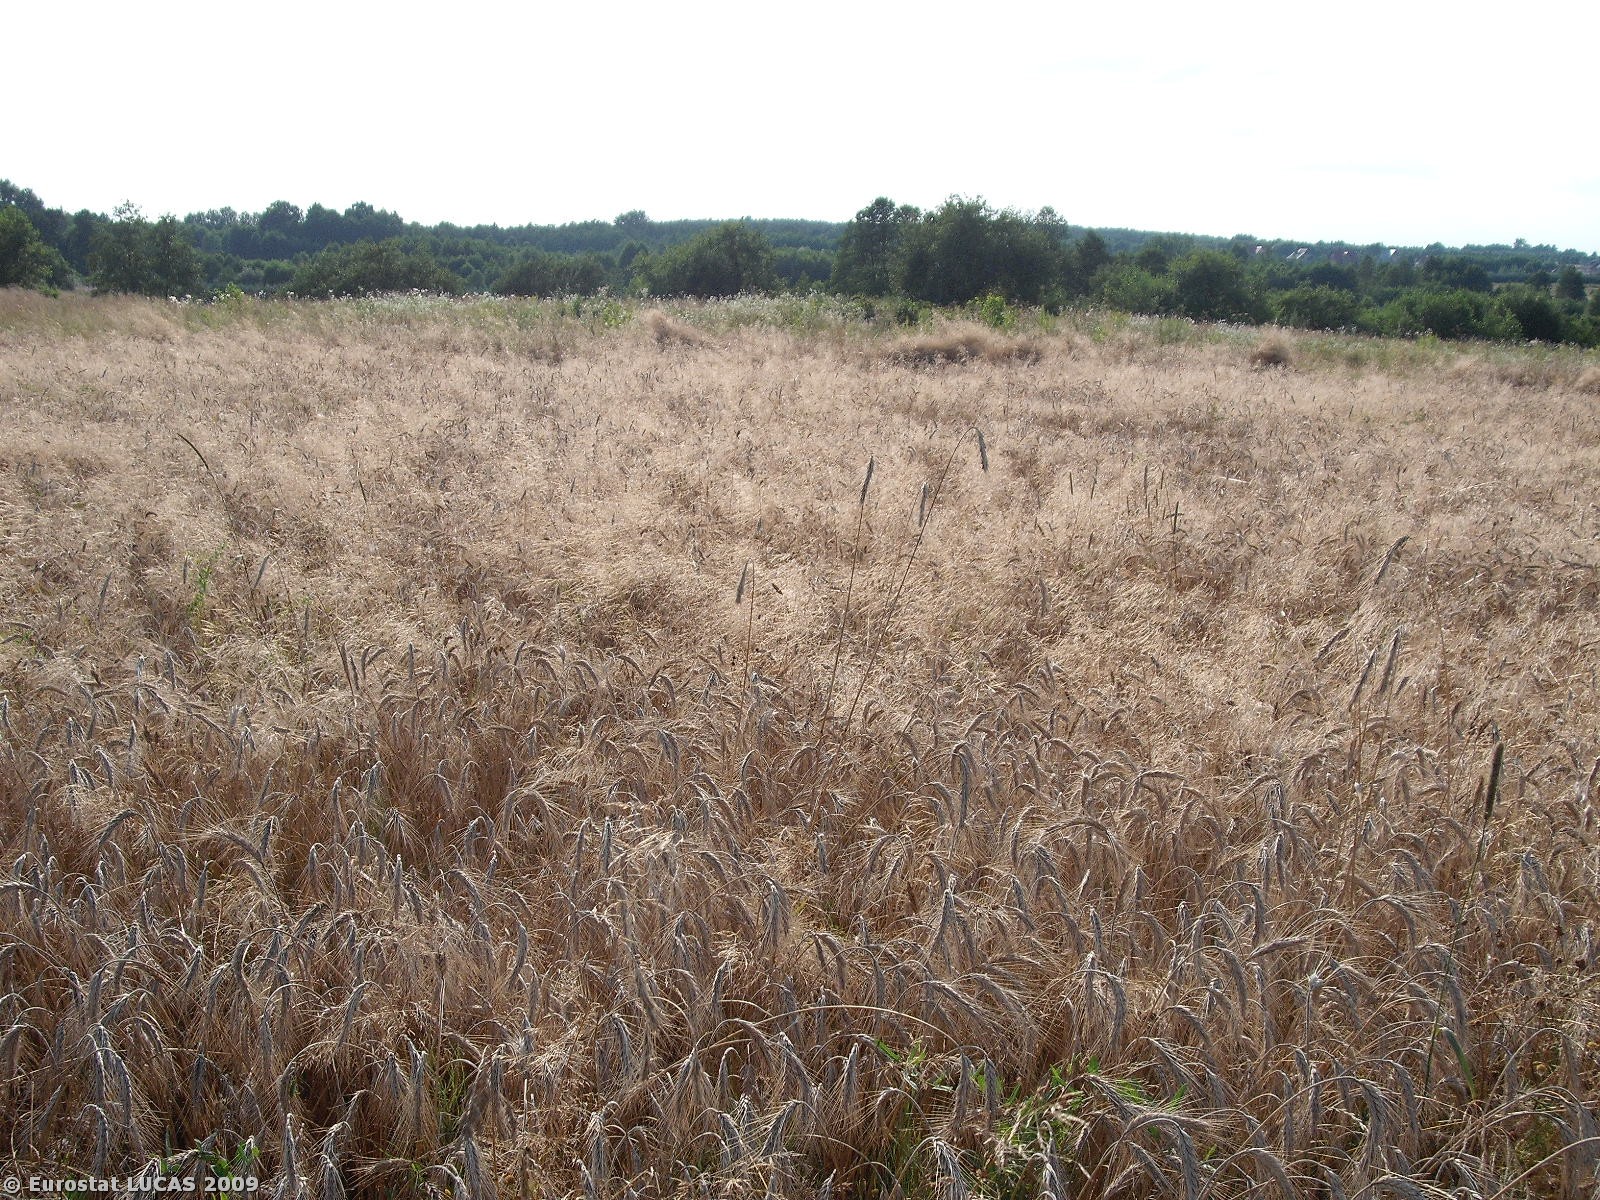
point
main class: Cropland
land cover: Triticale
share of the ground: > 75 %
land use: Agriculture (excluding fallow land and kitchen gardens)
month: July
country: PL
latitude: 50.5648
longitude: 21.2998
